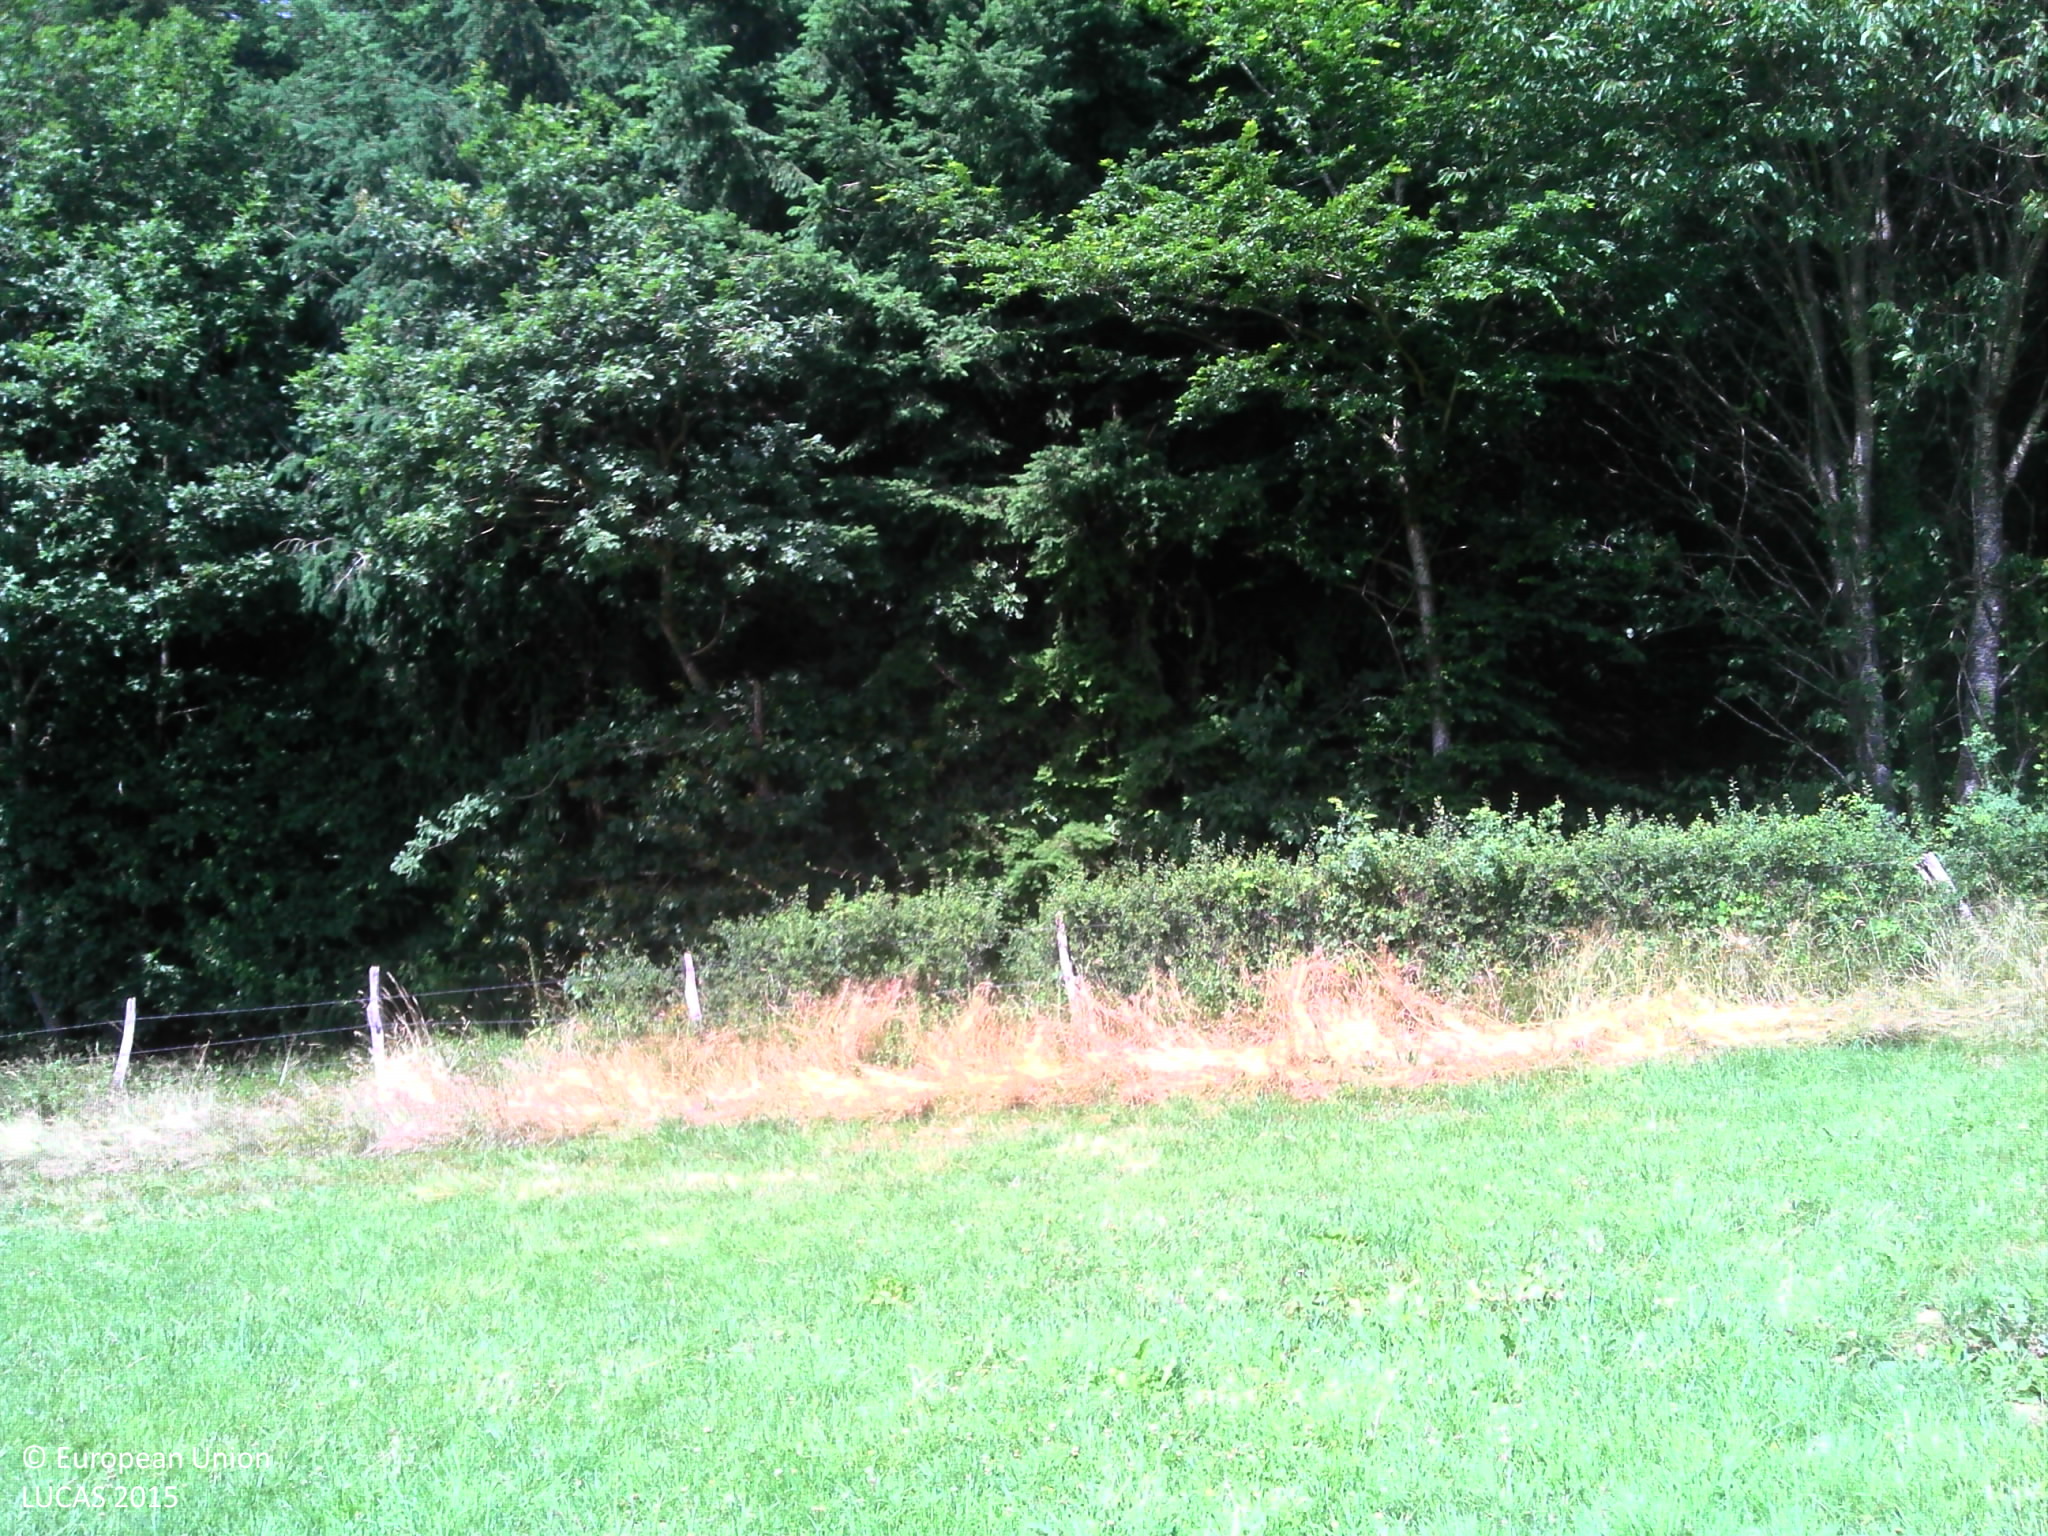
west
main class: Cropland
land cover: Temporary grasslands
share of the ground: > 75 %
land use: Agriculture (excluding fallow land and kitchen gardens)
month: June
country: FR
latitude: 46.4415
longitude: 4.4434
